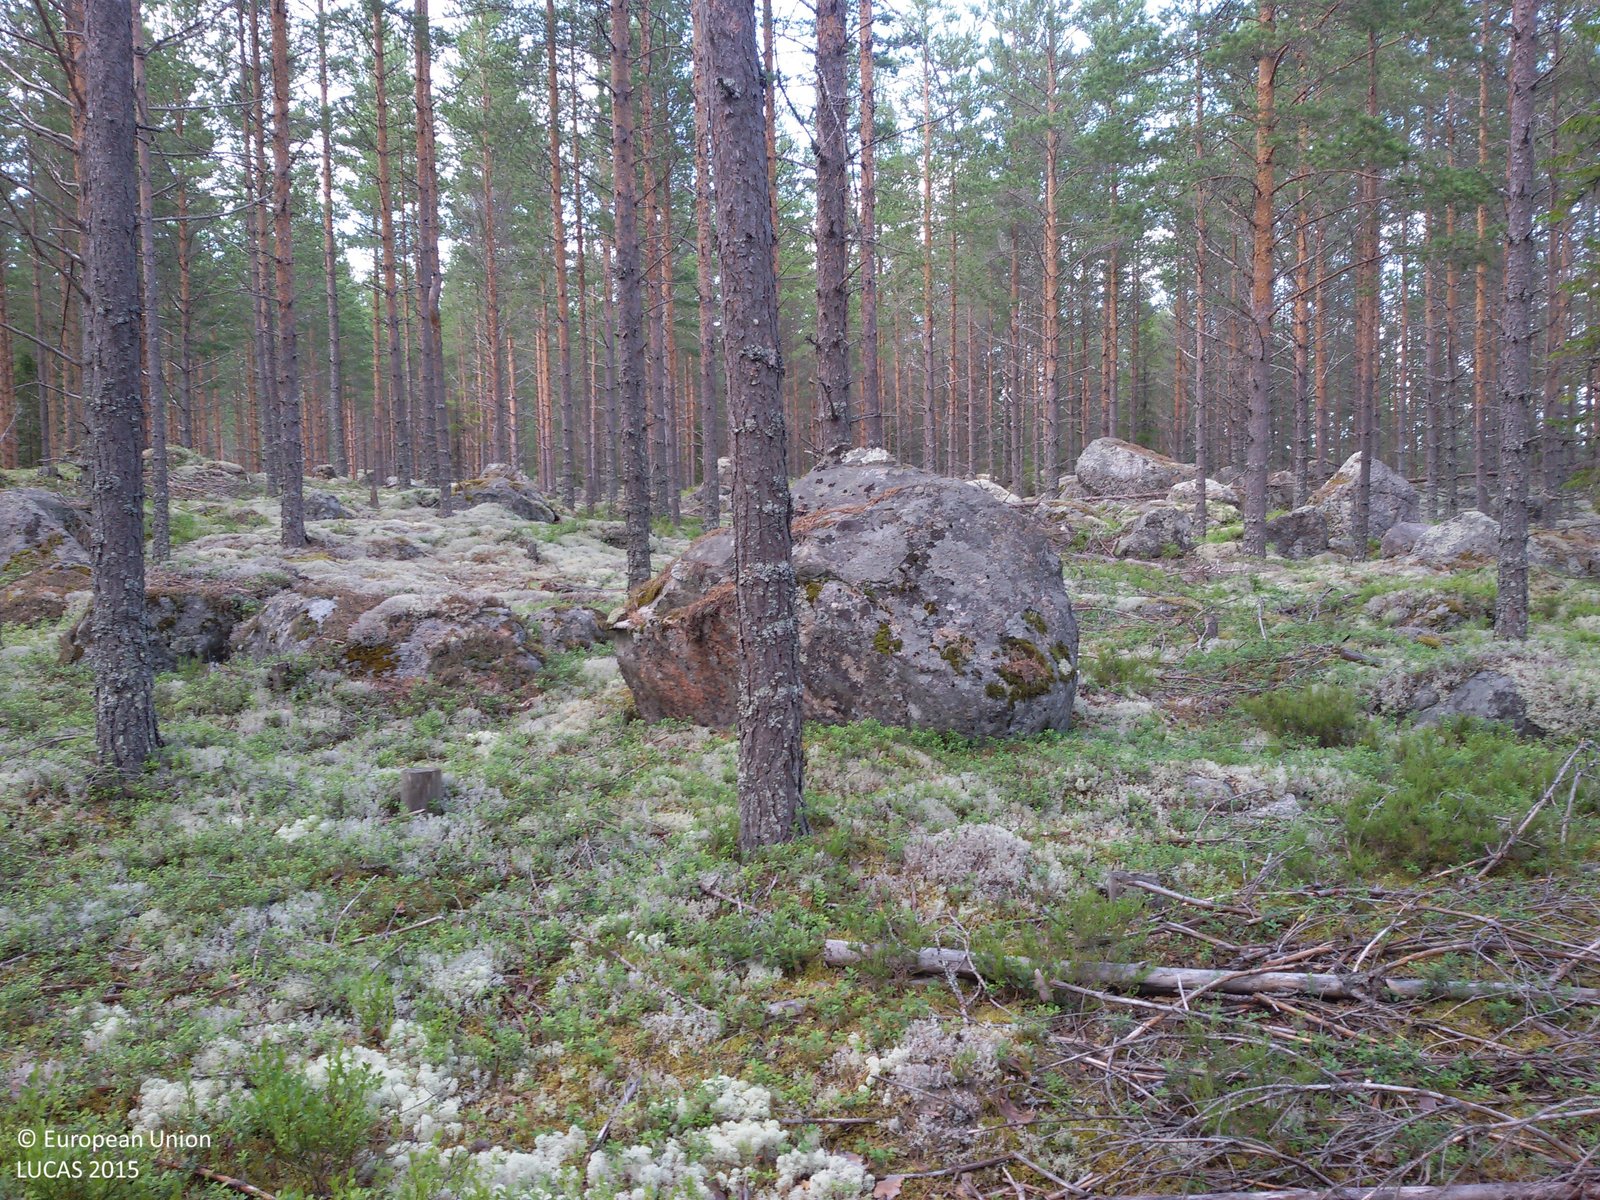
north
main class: Woodland
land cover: Pine dominated coniferous woodland
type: boreal forest
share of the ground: 50 - 75 %
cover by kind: coniferous forest trees 70 %, herbaceous plants 15 %, lichens and mosses 15 %
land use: Forestry
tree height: > 5 m
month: July
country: SE
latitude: 60.3482
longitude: 14.8991
